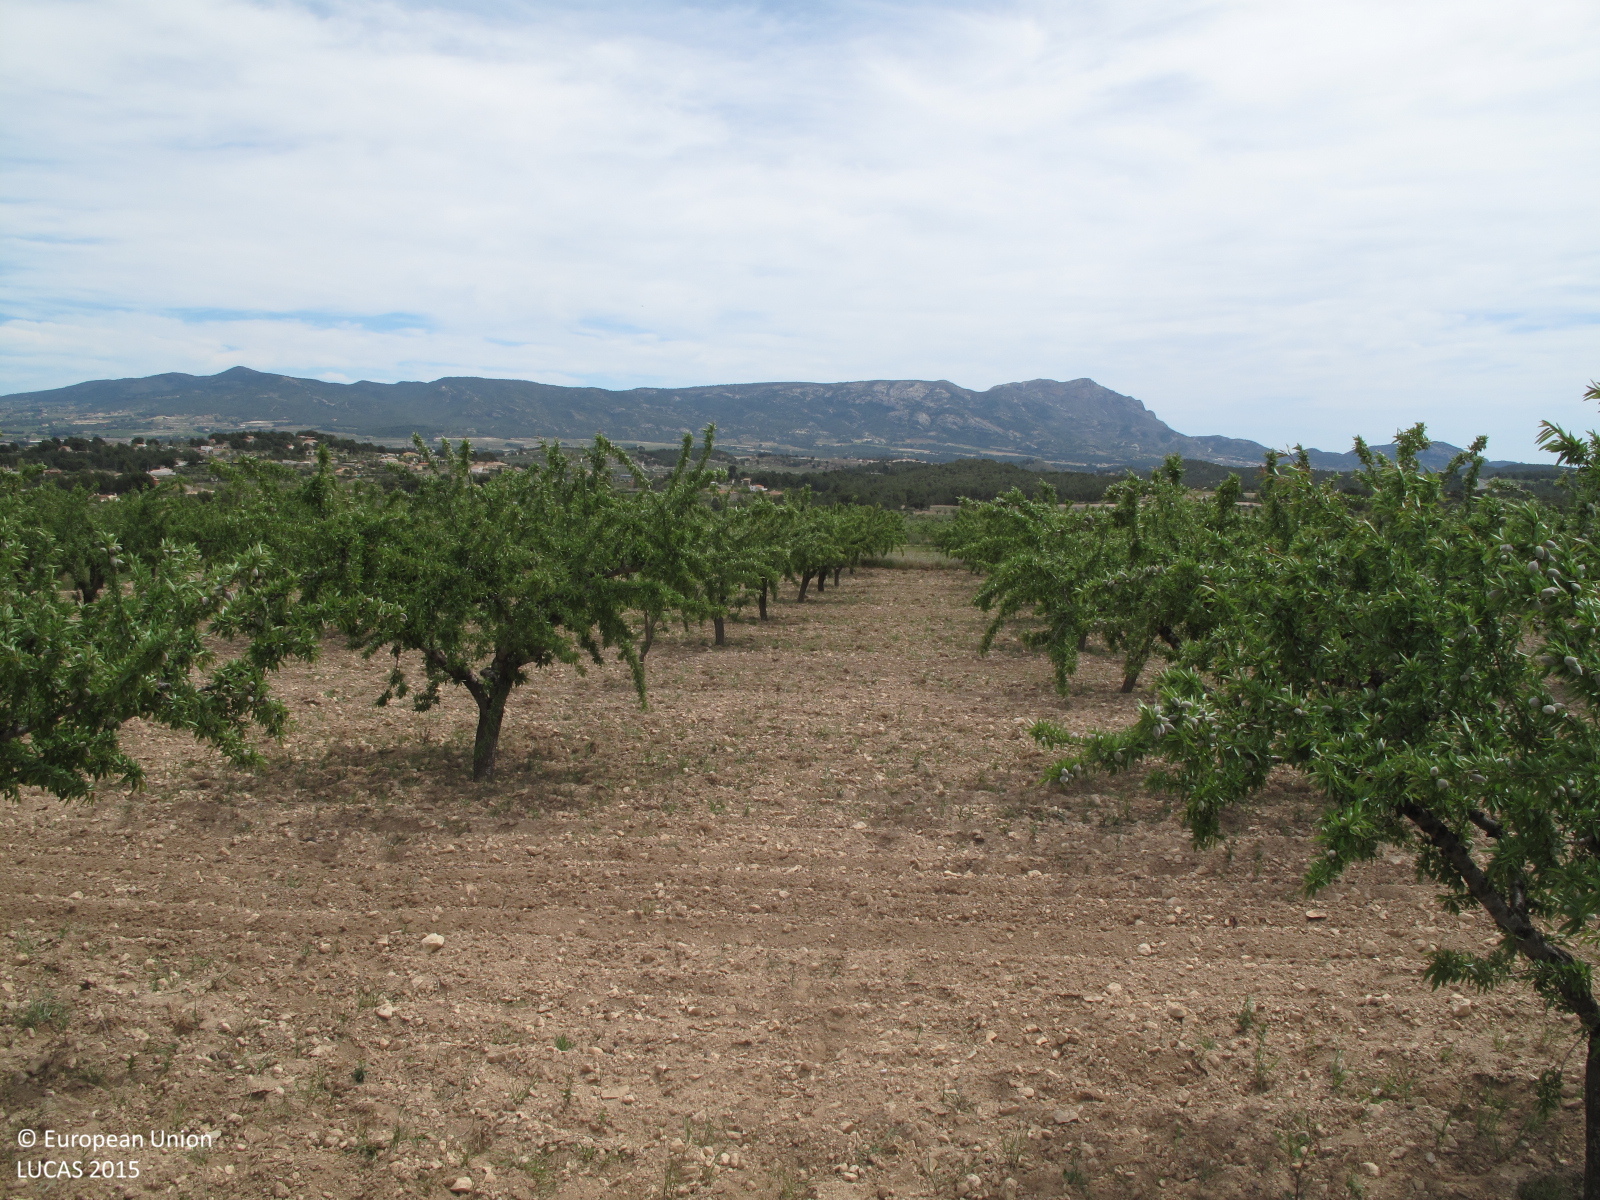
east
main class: Cropland
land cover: Olive groves
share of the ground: < 10 %
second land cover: Spontaneously vegetated surfaces
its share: > 75 %
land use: Agriculture (excluding fallow land and kitchen gardens)
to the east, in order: Olive groves; Spontaneously vegetated surfaces; Fences; Grass margins; Nuts trees; Grass margins; Tracks; Grass margins; Nuts trees; Grass margins; Tracks; Grass margins; Nuts trees; Grass margins; Tracks; Nuts trees
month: April
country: ES
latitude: 38.5701
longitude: -0.6743
